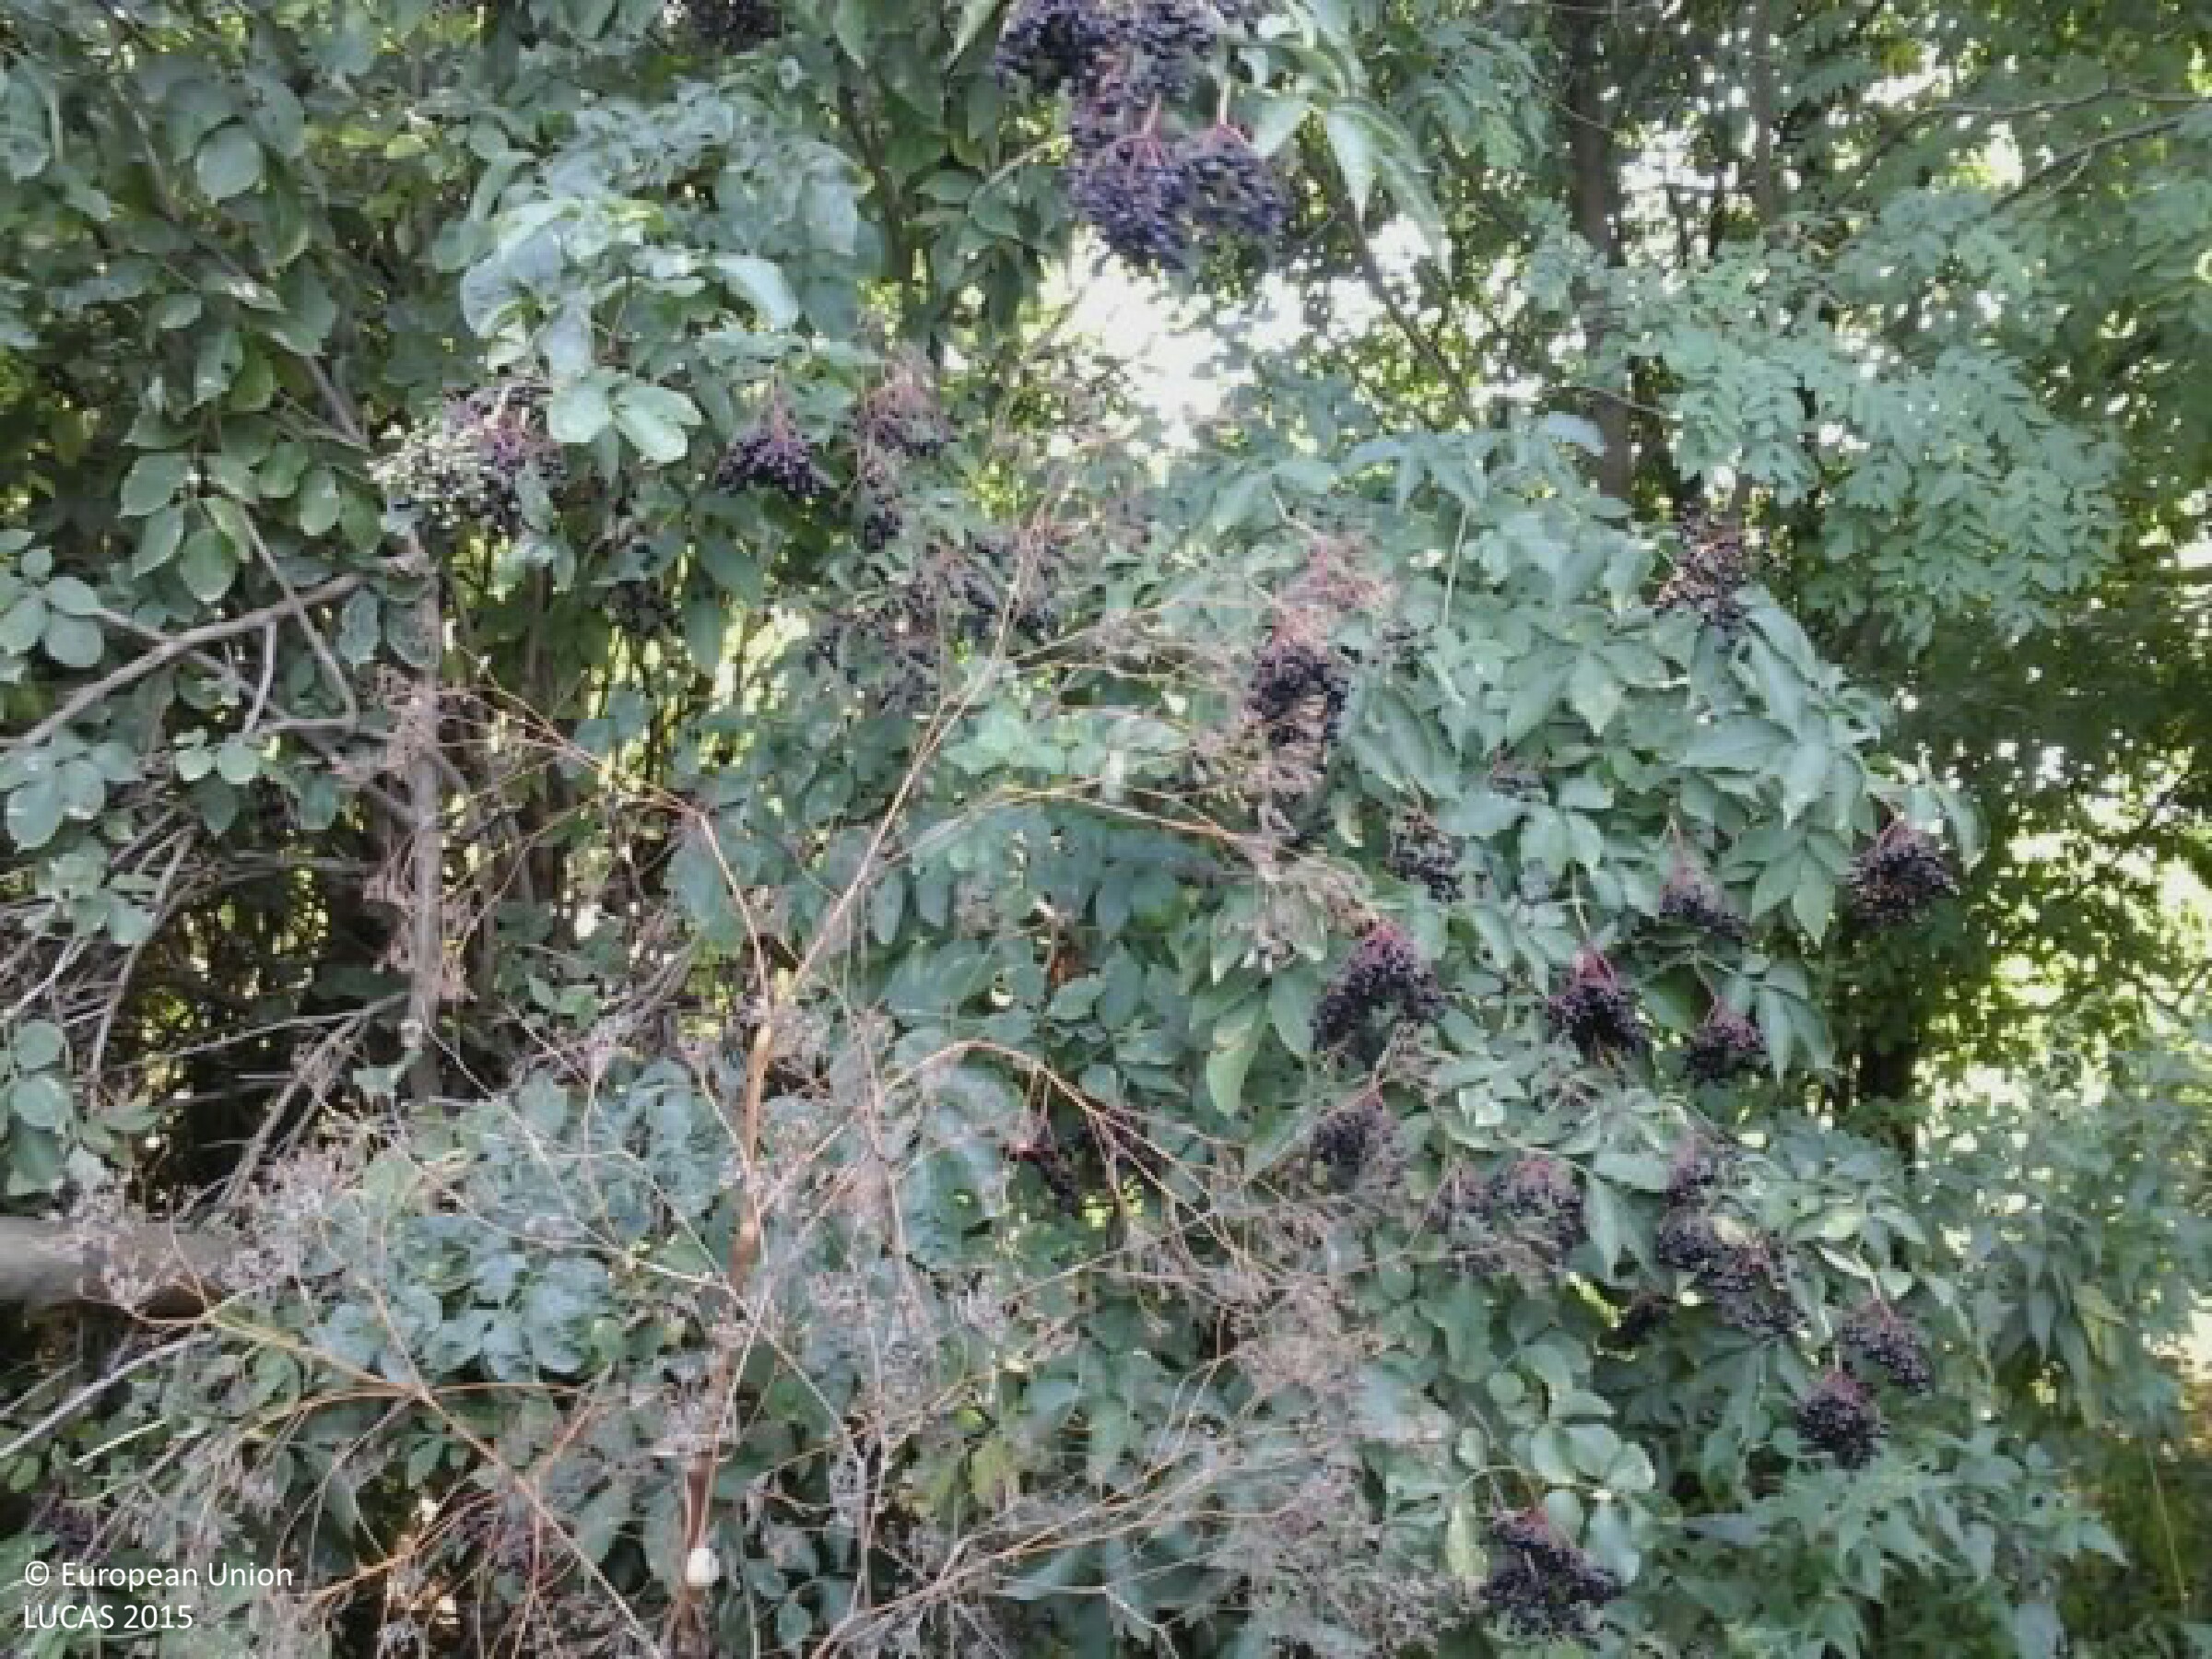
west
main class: Cropland
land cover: Maize
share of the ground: > 75 %
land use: Agriculture (excluding fallow land and kitchen gardens)
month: August
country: HU
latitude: 46.4682
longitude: 17.9901
